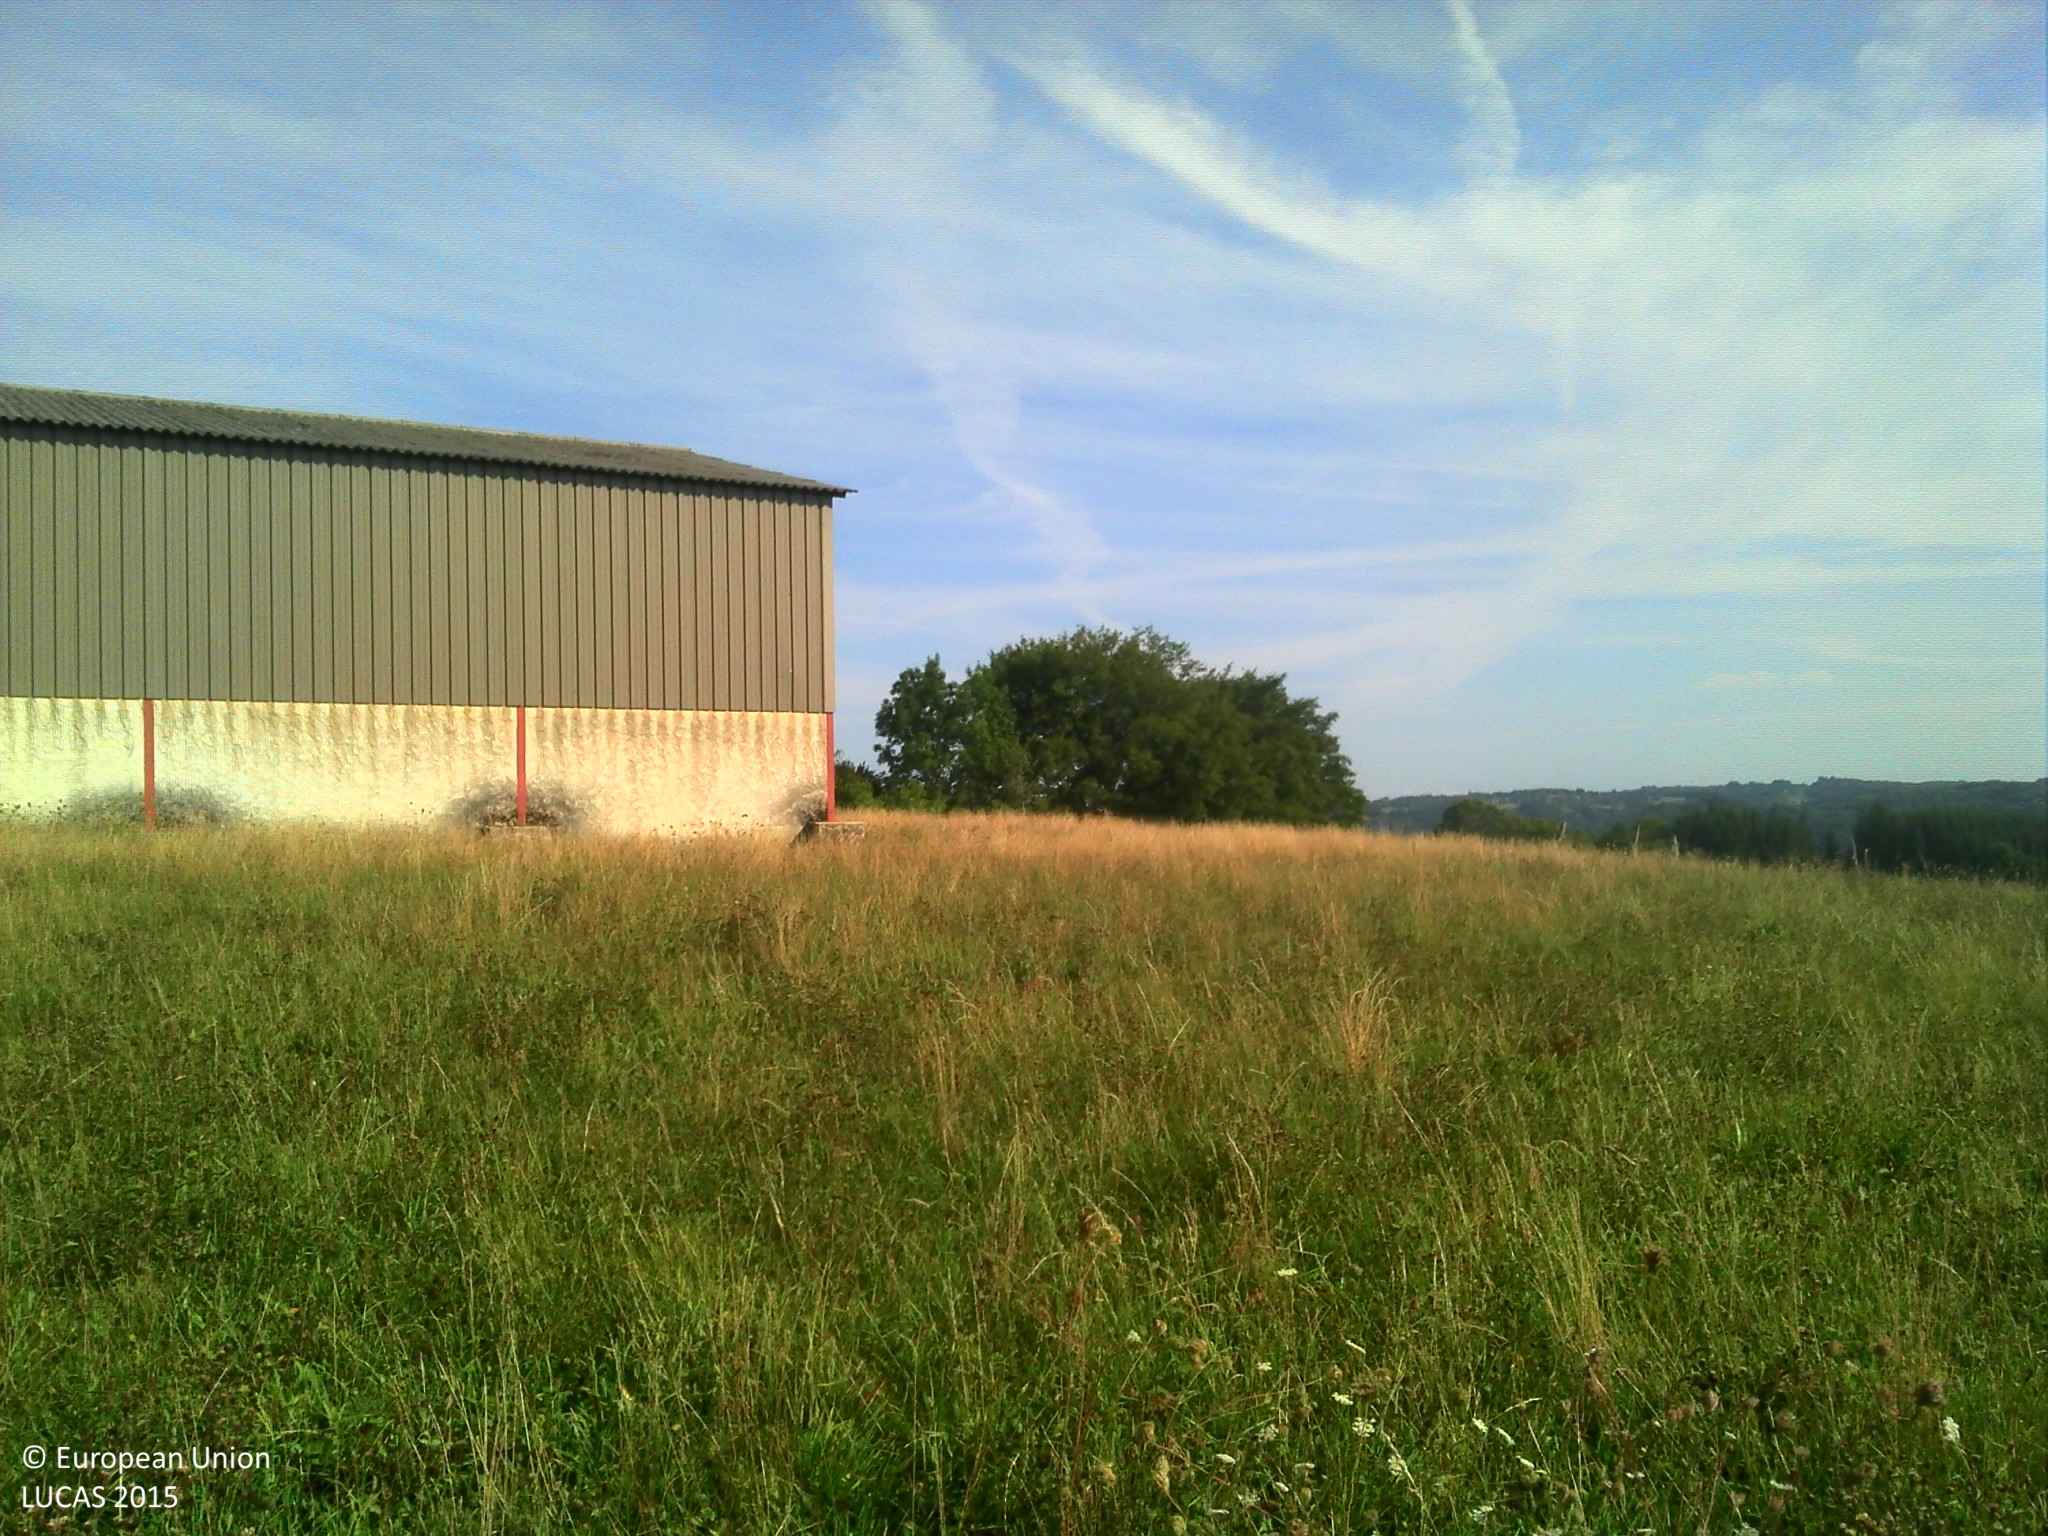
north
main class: Grassland
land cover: Grassland without tree/shrub cover
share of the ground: > 75 %
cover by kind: herbaceous plants 100 %
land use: Agriculture (excluding fallow land and kitchen gardens)
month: August
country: FR
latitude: 44.8178
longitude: 1.9689
